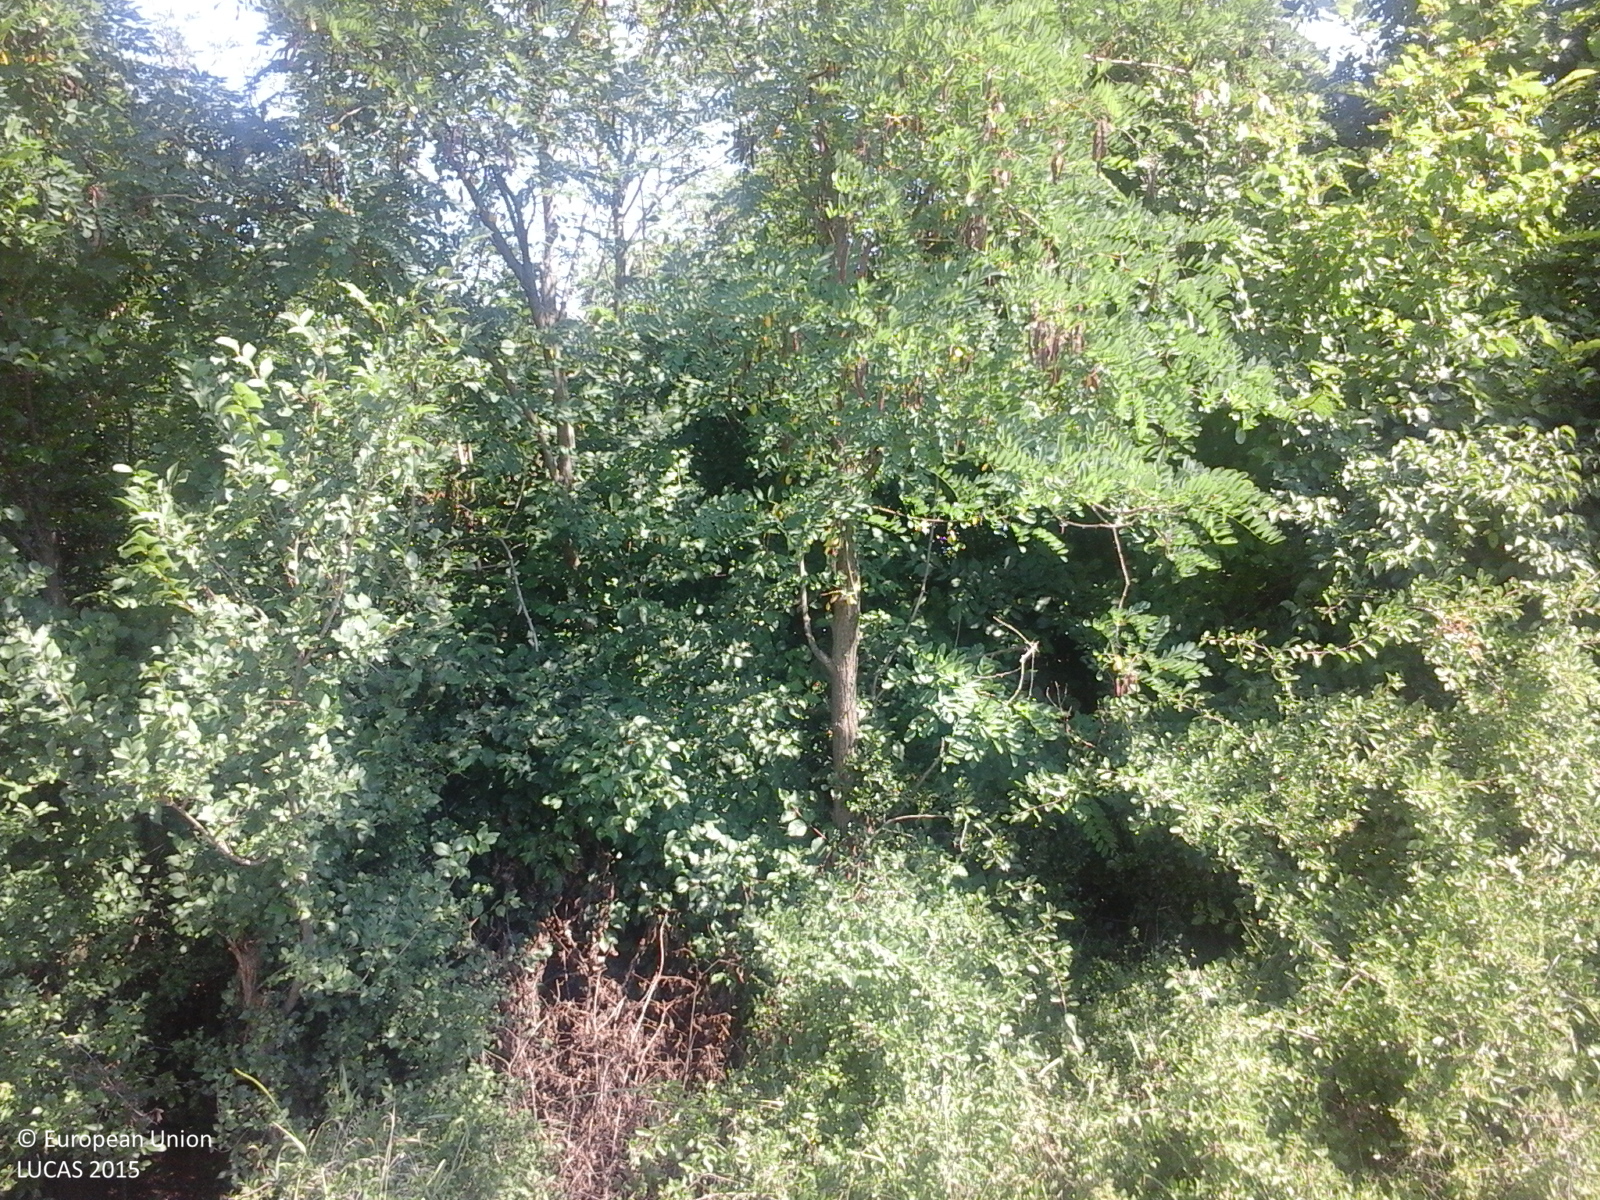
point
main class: Woodland
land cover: Broadleaved woodland
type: exotic forest
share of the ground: > 75 %
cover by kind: broadleaved forest trees 100 %
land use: Forestry
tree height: > 5 m
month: July
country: RO
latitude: 44.7194
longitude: 24.3483
